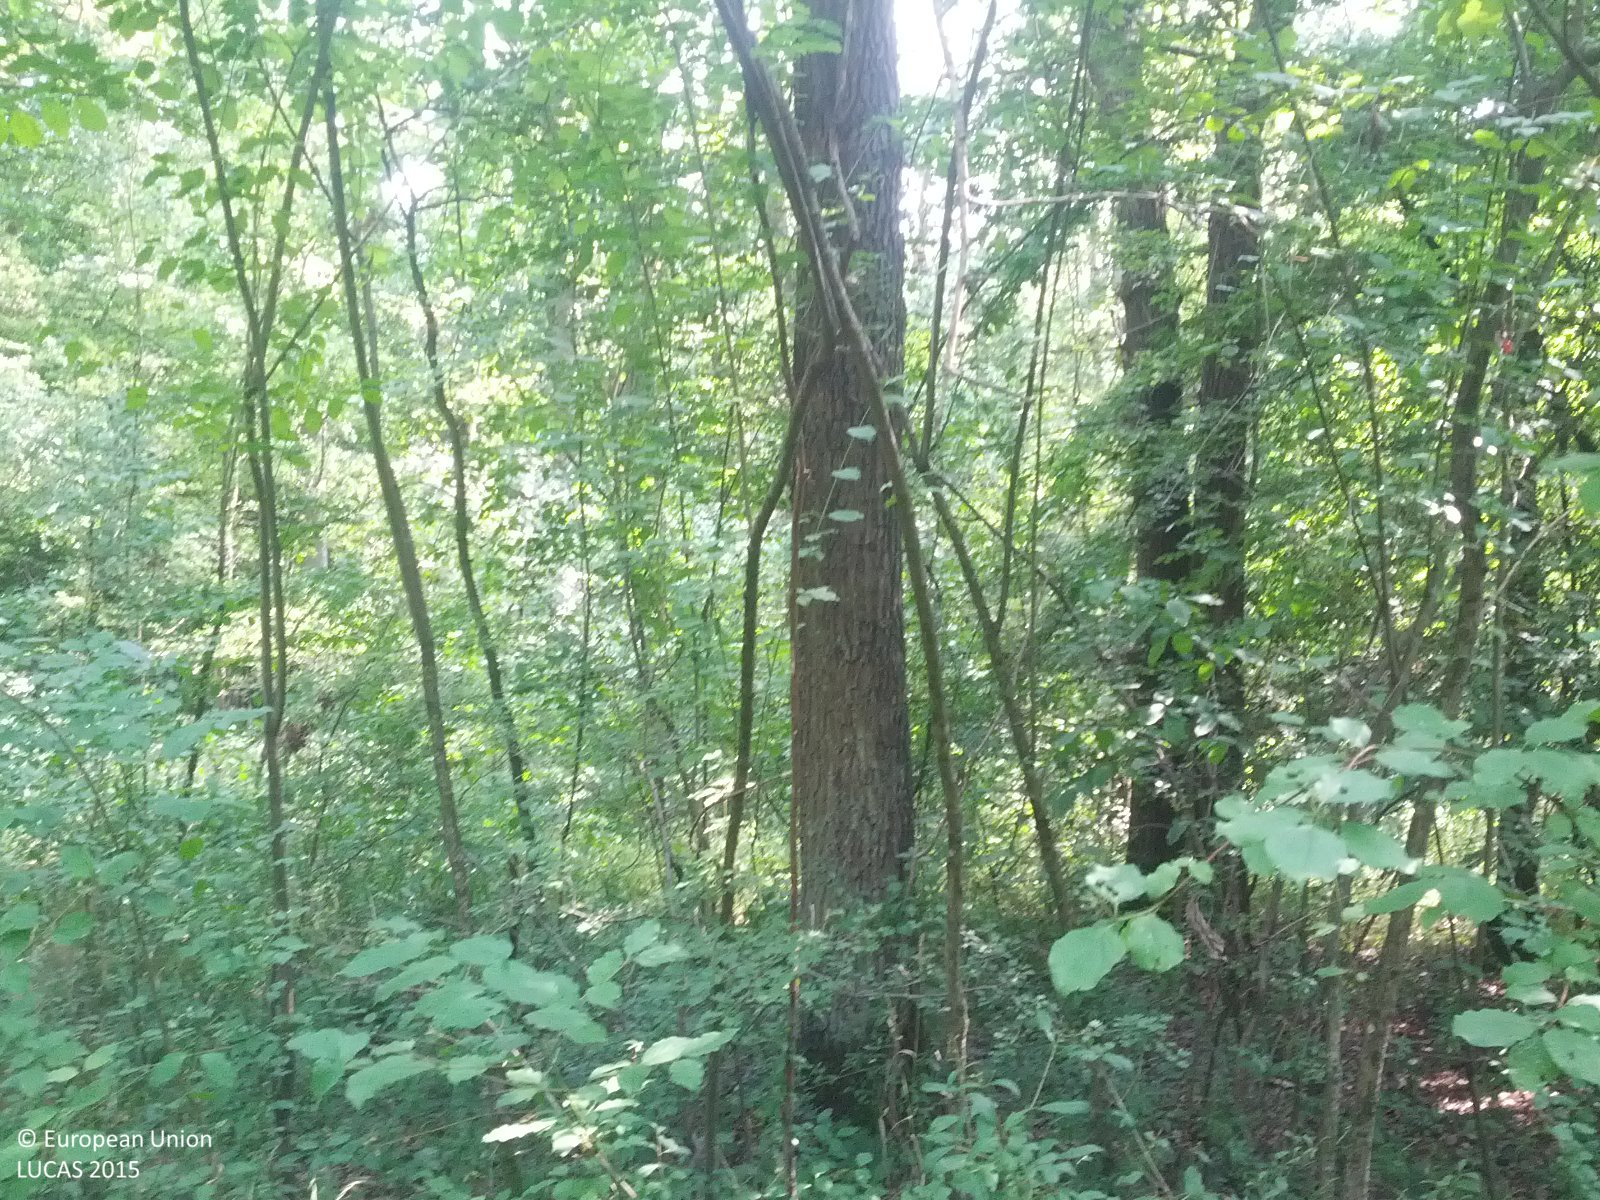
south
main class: Woodland
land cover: Broadleaved woodland
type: acidophilous oak and oak-birch forest
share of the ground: > 75 %
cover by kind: broadleaved forest trees 80 %, herbaceous plants 15 %, shrubs 5 %
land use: Forestry
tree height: > 5 m
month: July
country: AT
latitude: 48.3856
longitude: 16.3112
